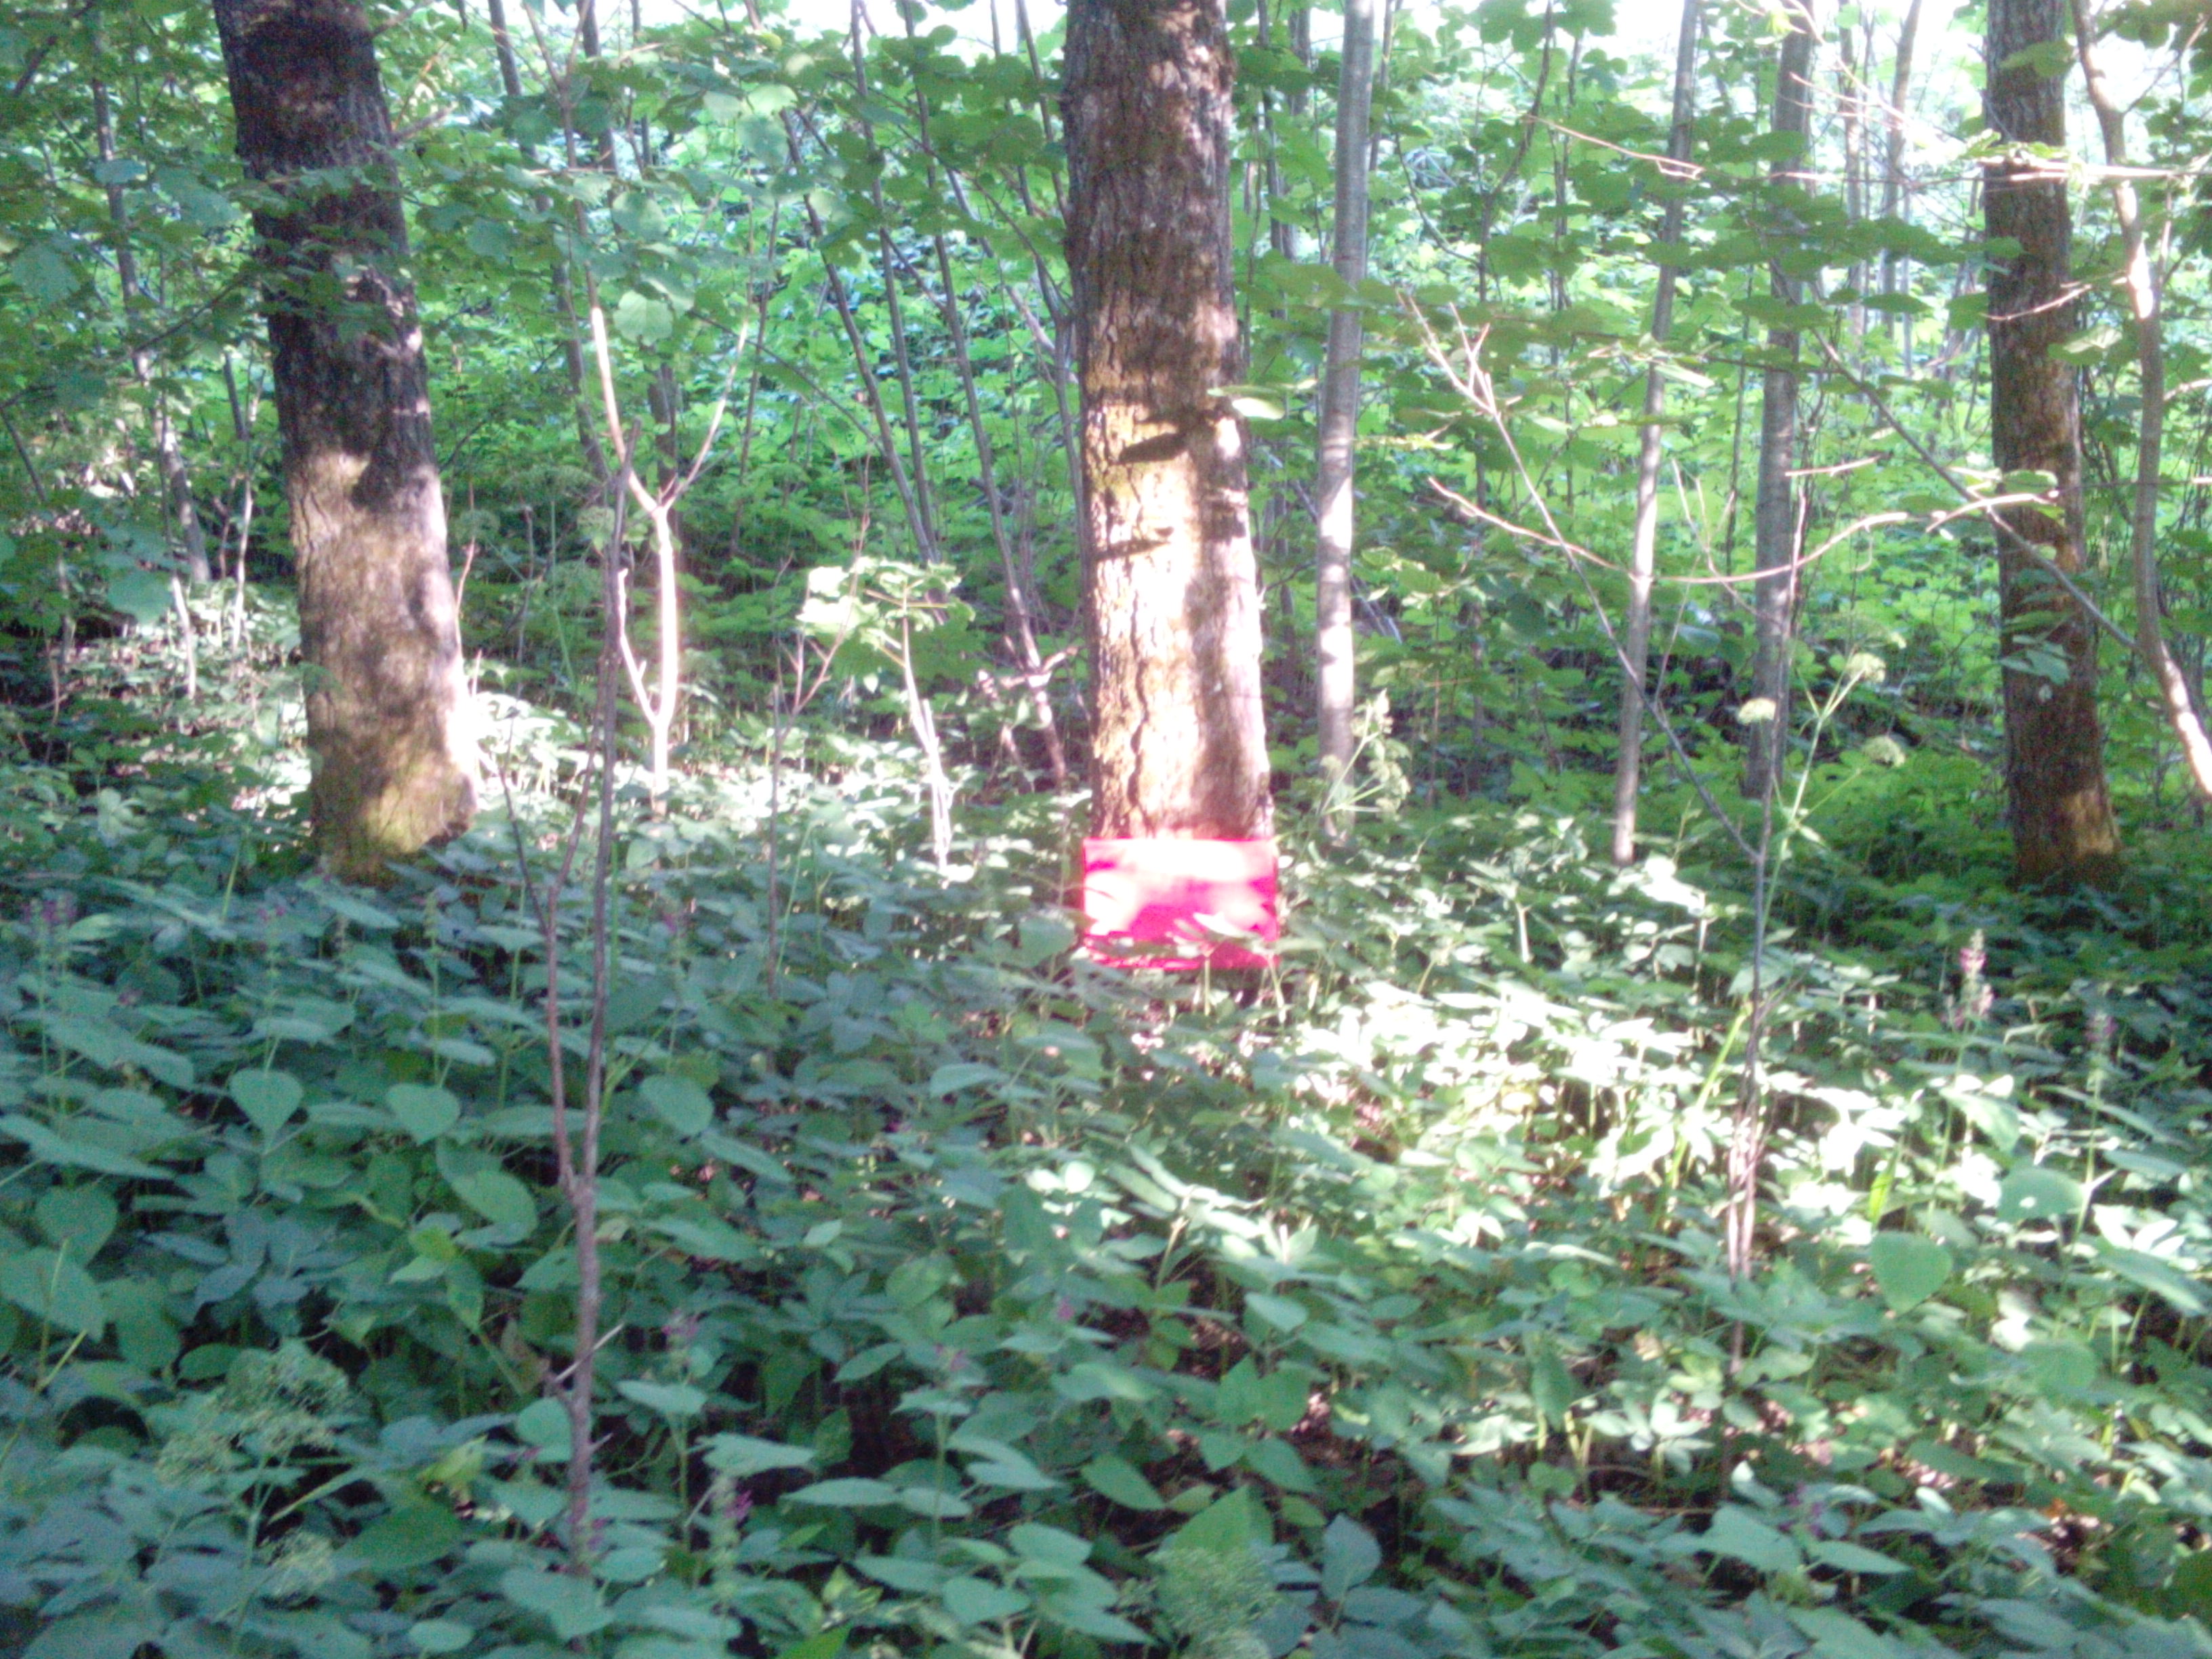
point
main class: Woodland
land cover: Broadleaved woodland
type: non-riverine alder, birch or aspen forest
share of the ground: > 75 %
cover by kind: broadleaved forest trees 85 %, herbaceous plants 10 %, shrubs 5 %
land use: Forestry
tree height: > 5 m
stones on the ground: < 10 %
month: July
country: LV
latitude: 56.5118
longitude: 21.8283
